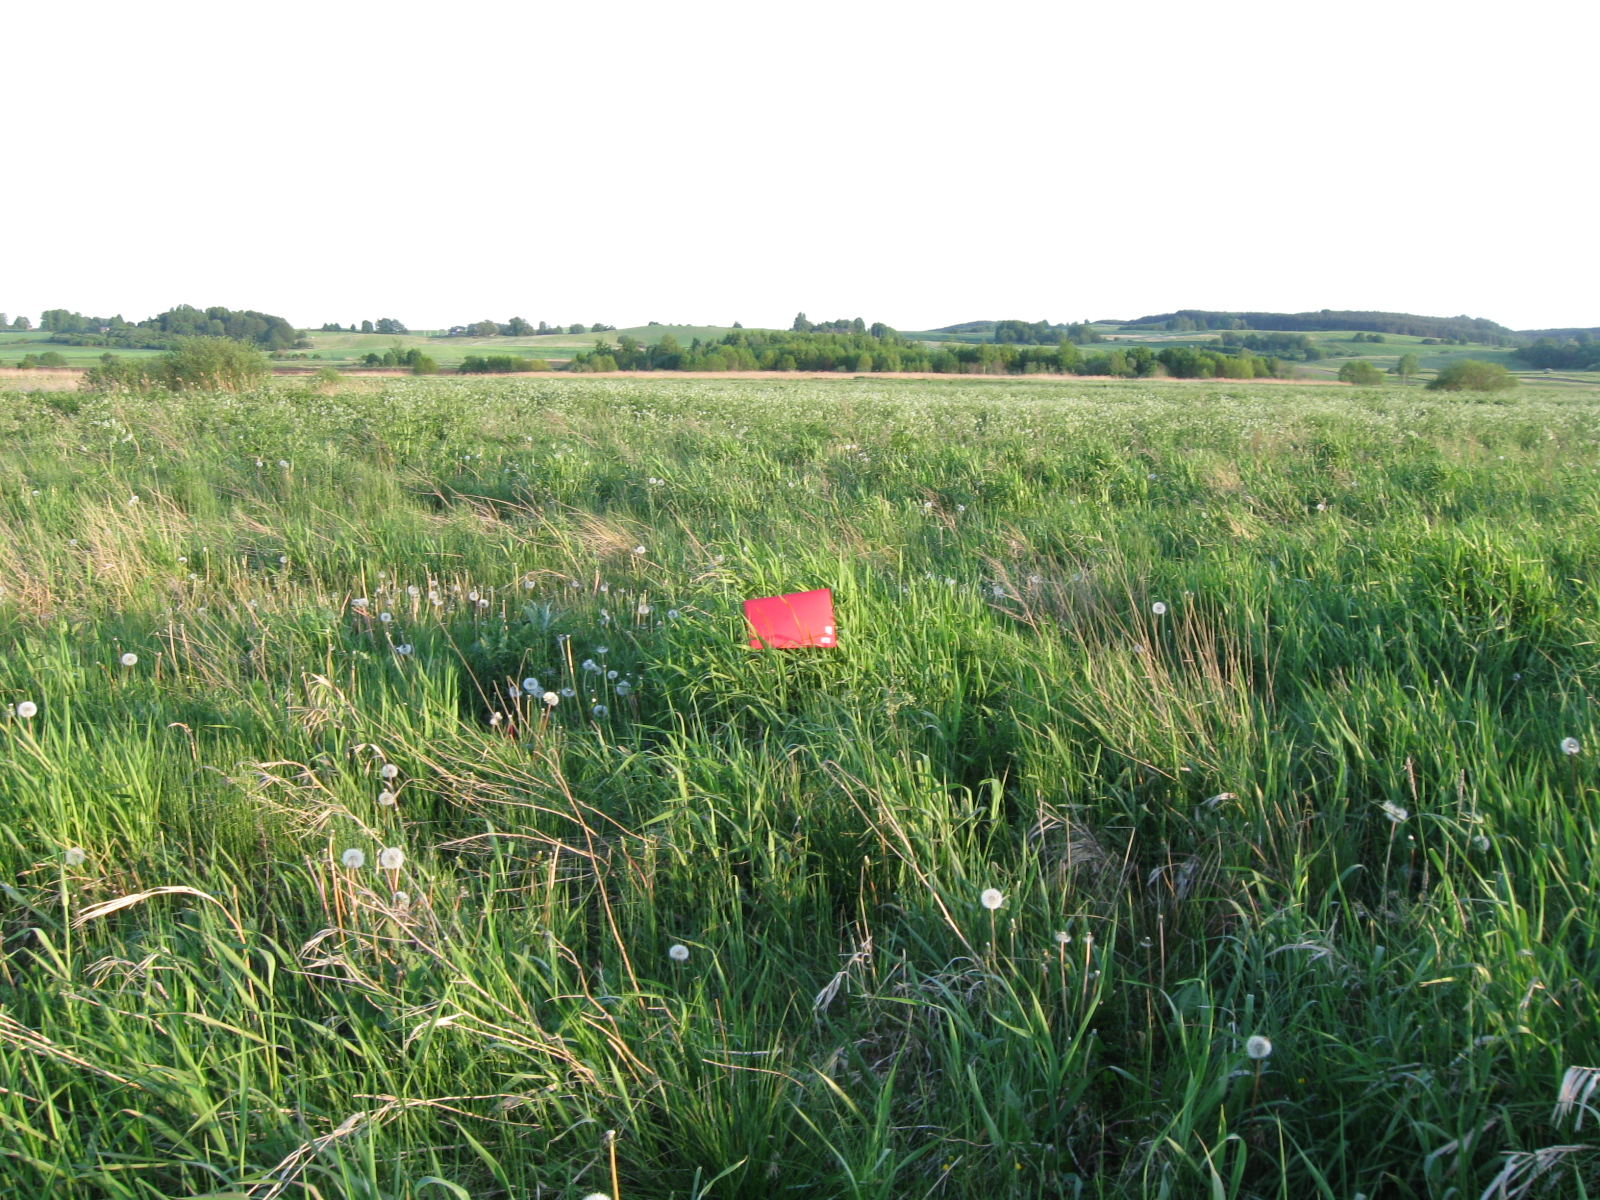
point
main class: Grassland
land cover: Grassland without tree/shrub cover
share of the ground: > 75 %
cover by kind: herbaceous plants 100 %
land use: Agriculture (excluding fallow land and kitchen gardens)
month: May
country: LT
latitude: 54.5596
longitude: 22.7955
